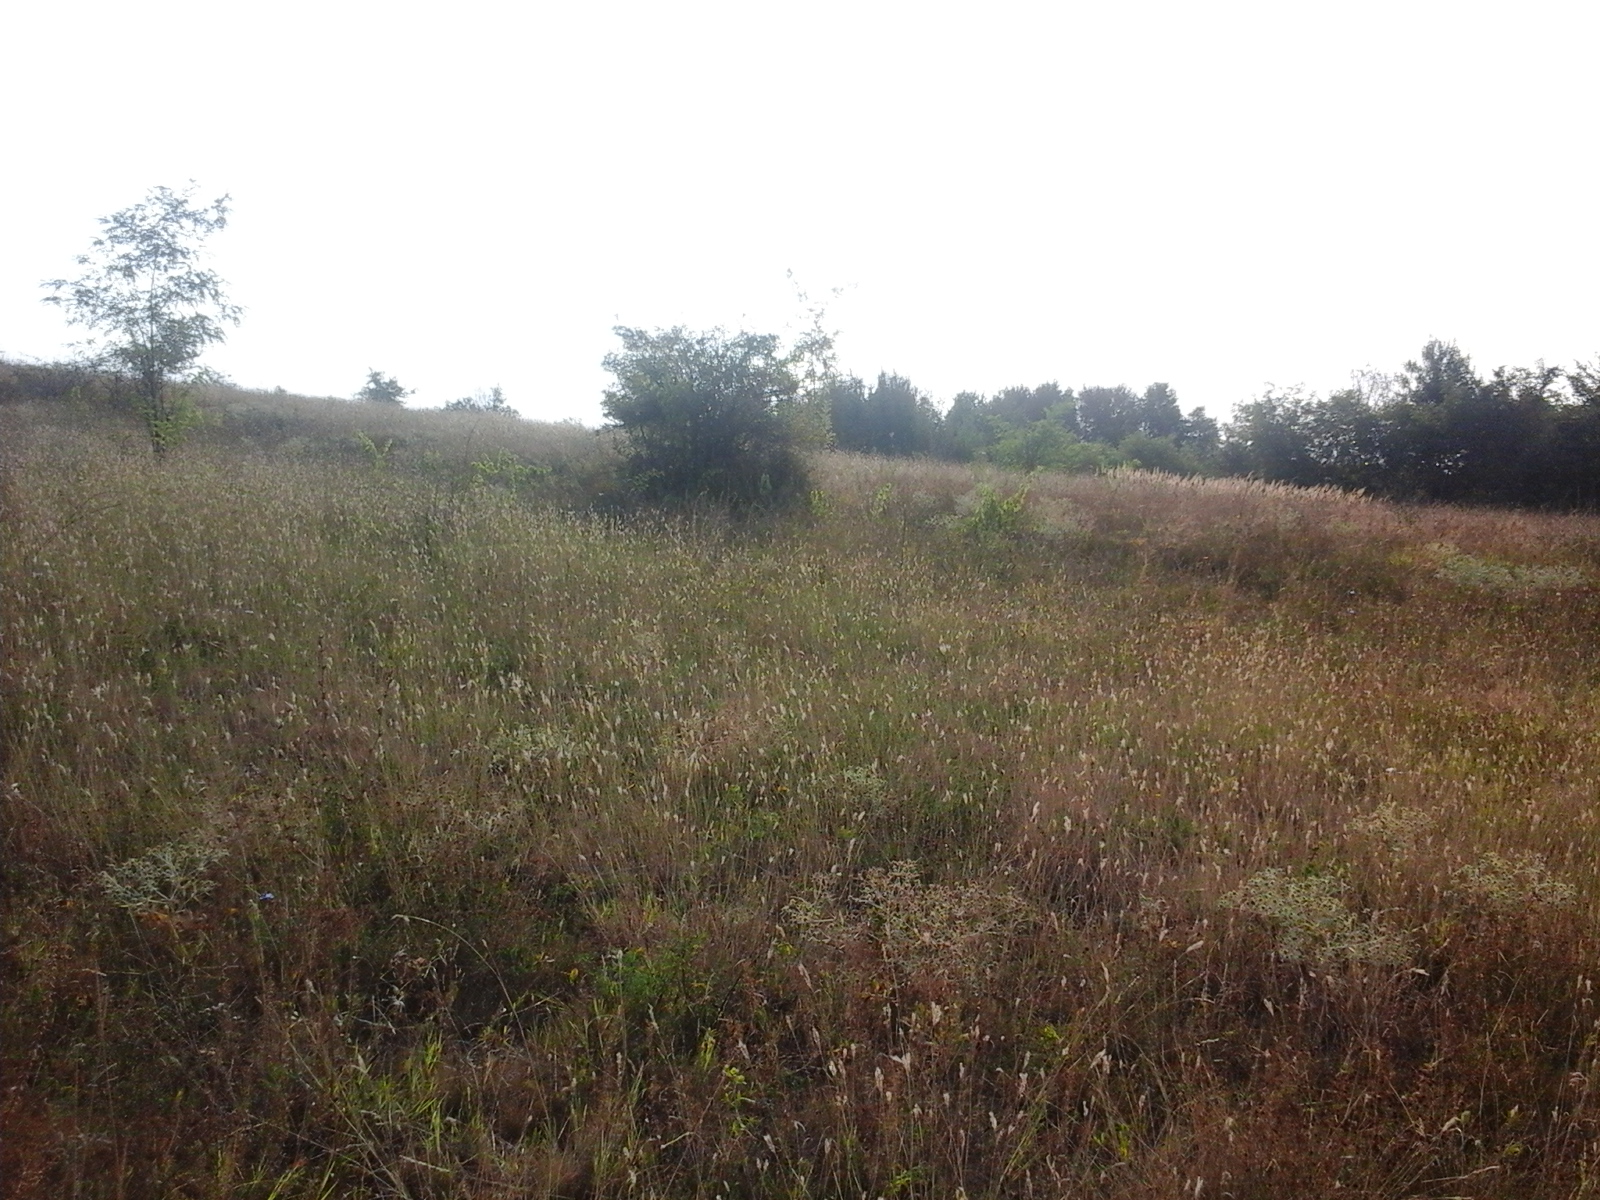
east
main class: Grassland
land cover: Grassland with sparse tree/shrub cover
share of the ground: > 75 %
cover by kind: herbaceous plants 90 %, broadleaved forest trees 5 %, shrubs 5 %
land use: Fallow land
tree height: < 5 m
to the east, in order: Grassland with sparse tree/shrub cover; Broadleaved woodland; Spontaneously vegetated surfaces
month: August
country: RO
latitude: 44.5120
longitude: 23.8592
